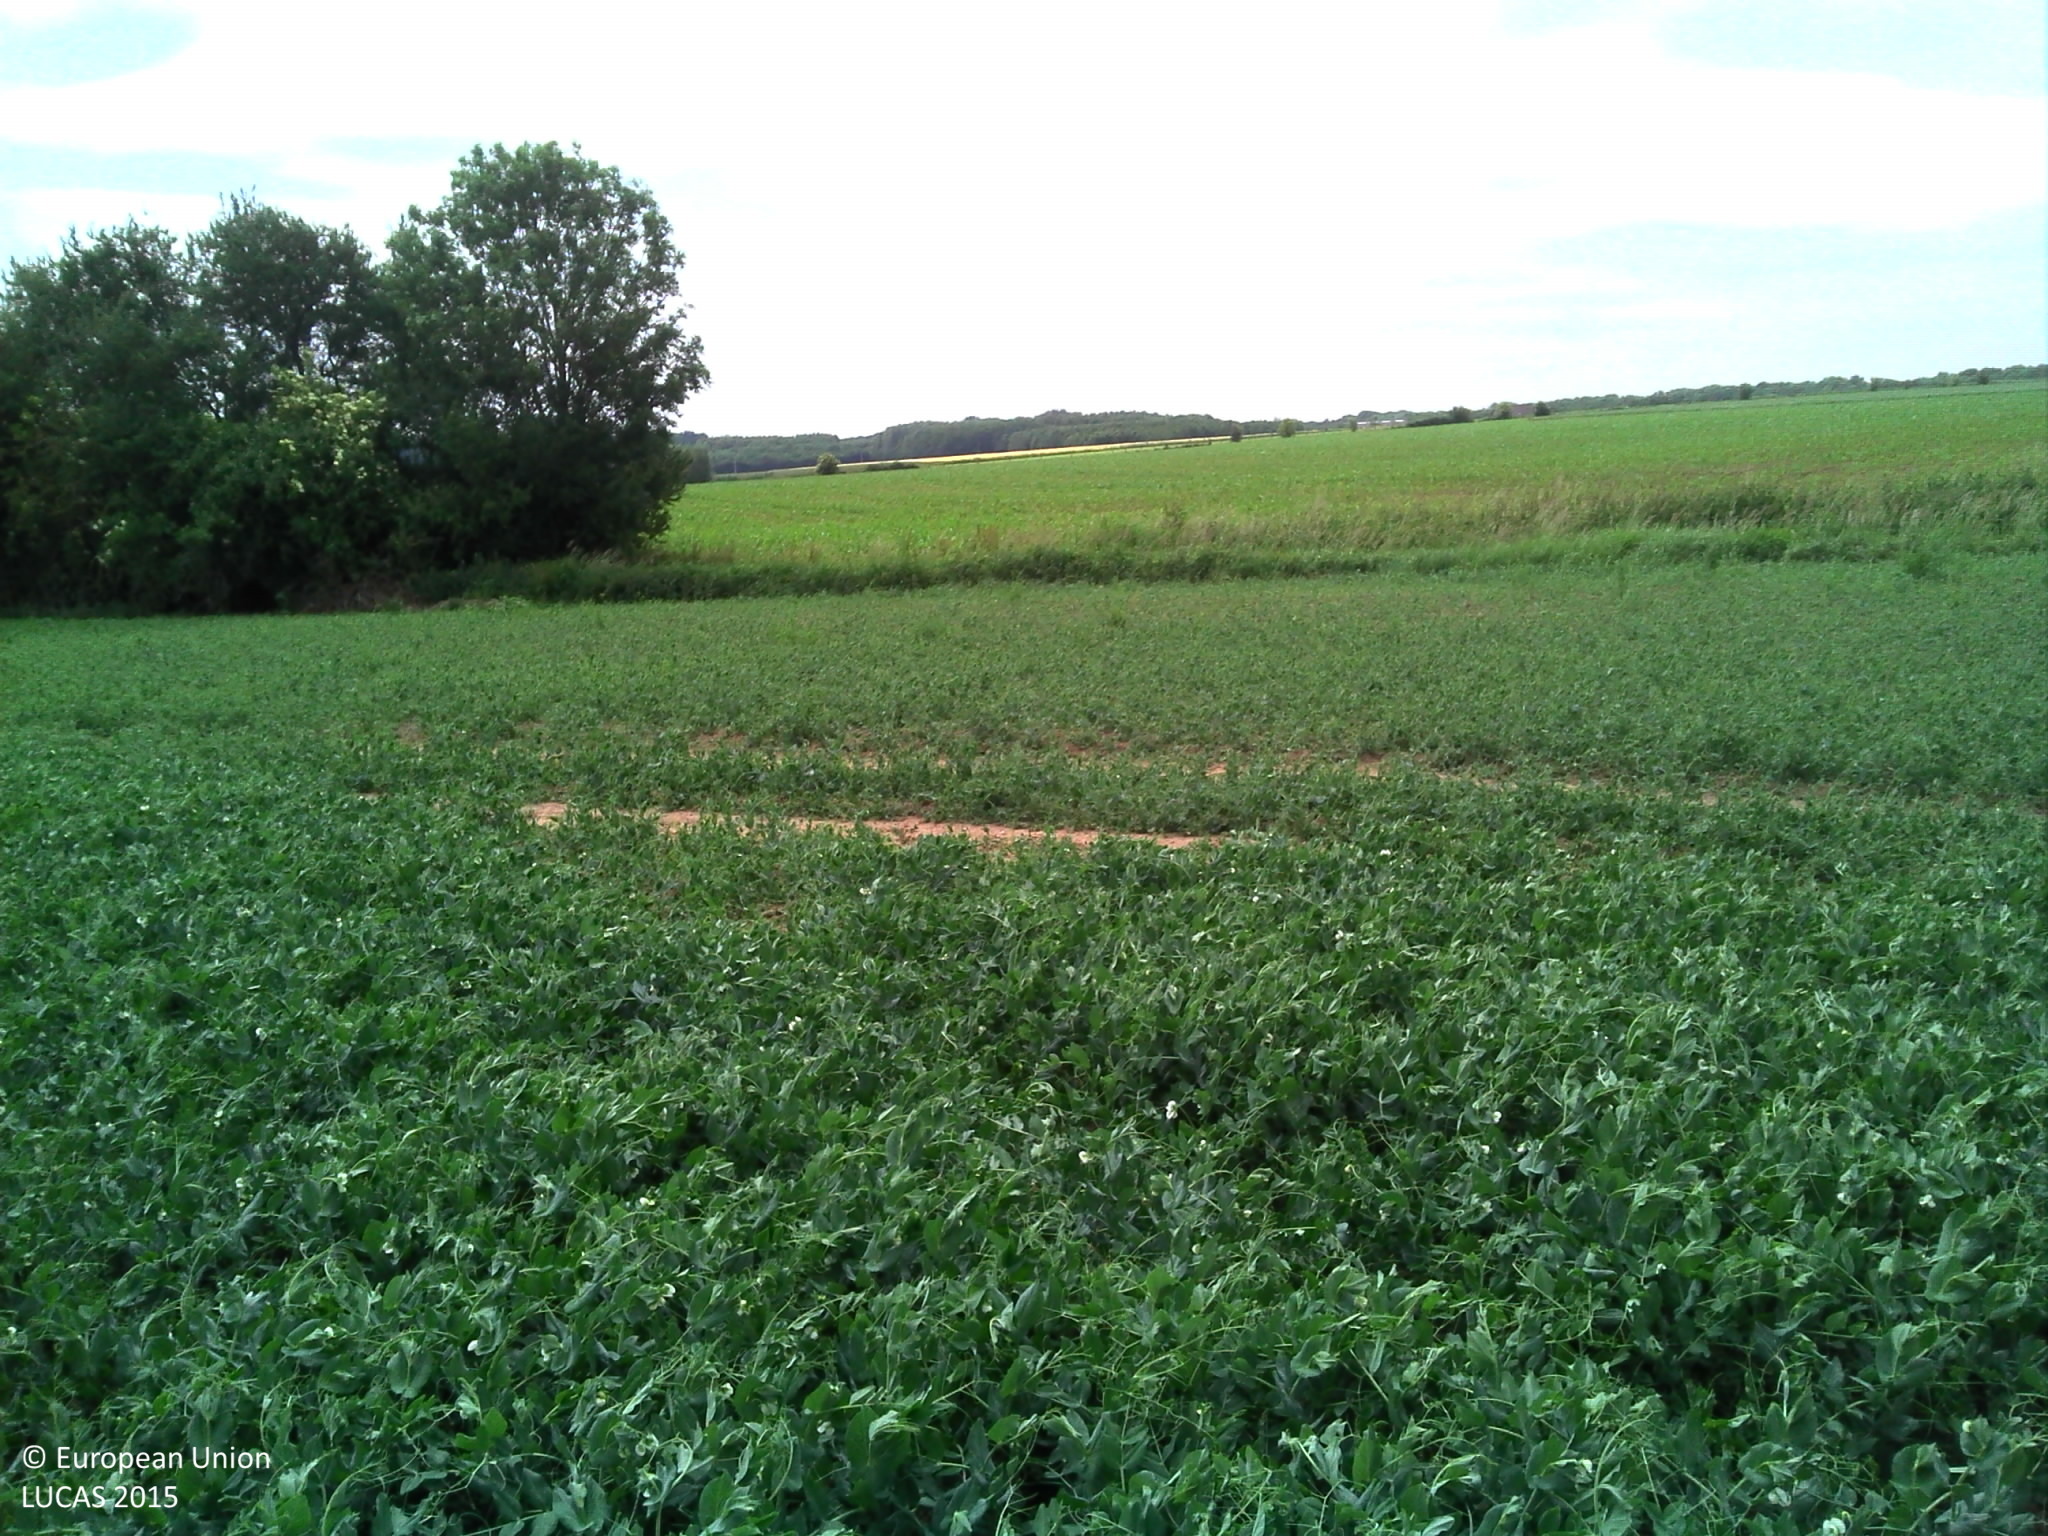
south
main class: Cropland
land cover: Dry pulses
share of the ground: > 75 %
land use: Agriculture (excluding fallow land and kitchen gardens)
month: June
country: BE
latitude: 50.8296
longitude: 2.9048
